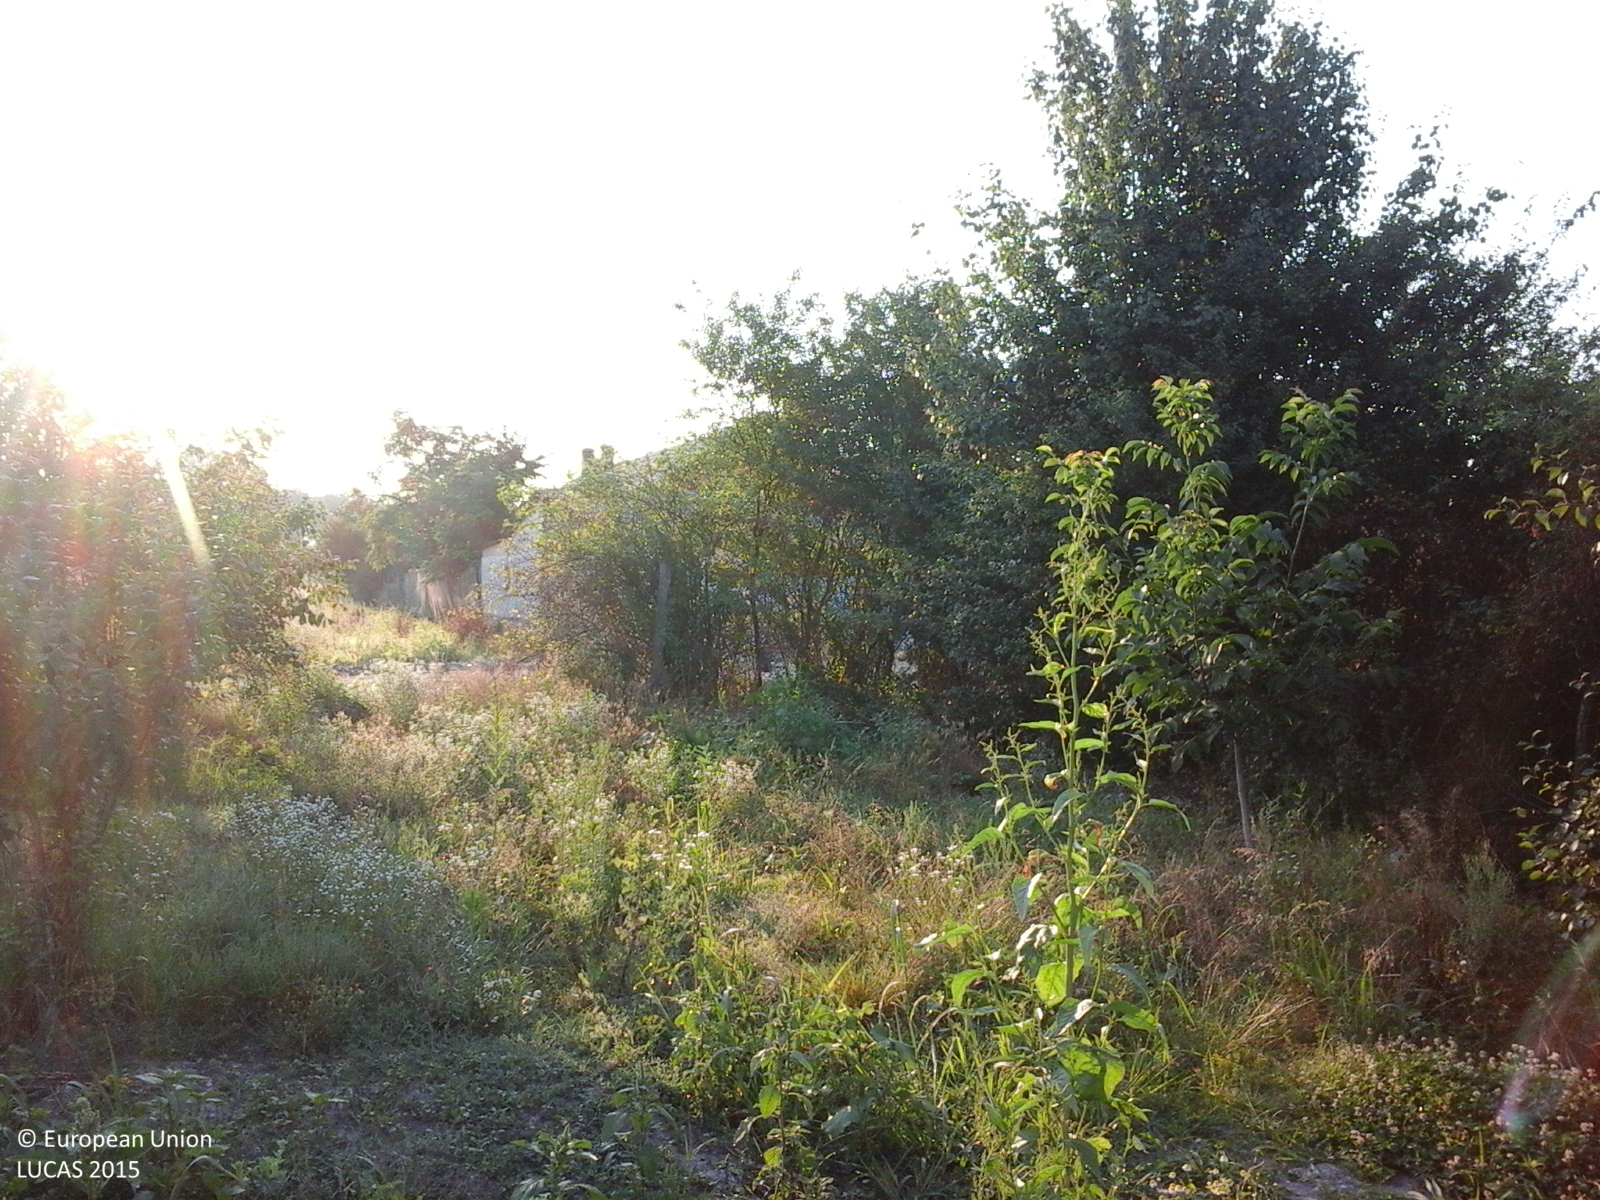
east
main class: Grassland
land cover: Spontaneously vegetated surfaces
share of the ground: 50 - 75 %
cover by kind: herbaceous plants 65 %, unconsolidated bare surface 35 %
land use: Agriculture (excluding fallow land and kitchen gardens)
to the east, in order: Spontaneously vegetated surfaces; Artificial constructions in urban areas; Other fresh vegetables; Grassland without tree/shrub cover; Artificial constructions in urban areas; Arable land (only in case pi)
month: July
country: RO
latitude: 44.5859
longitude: 24.6477
